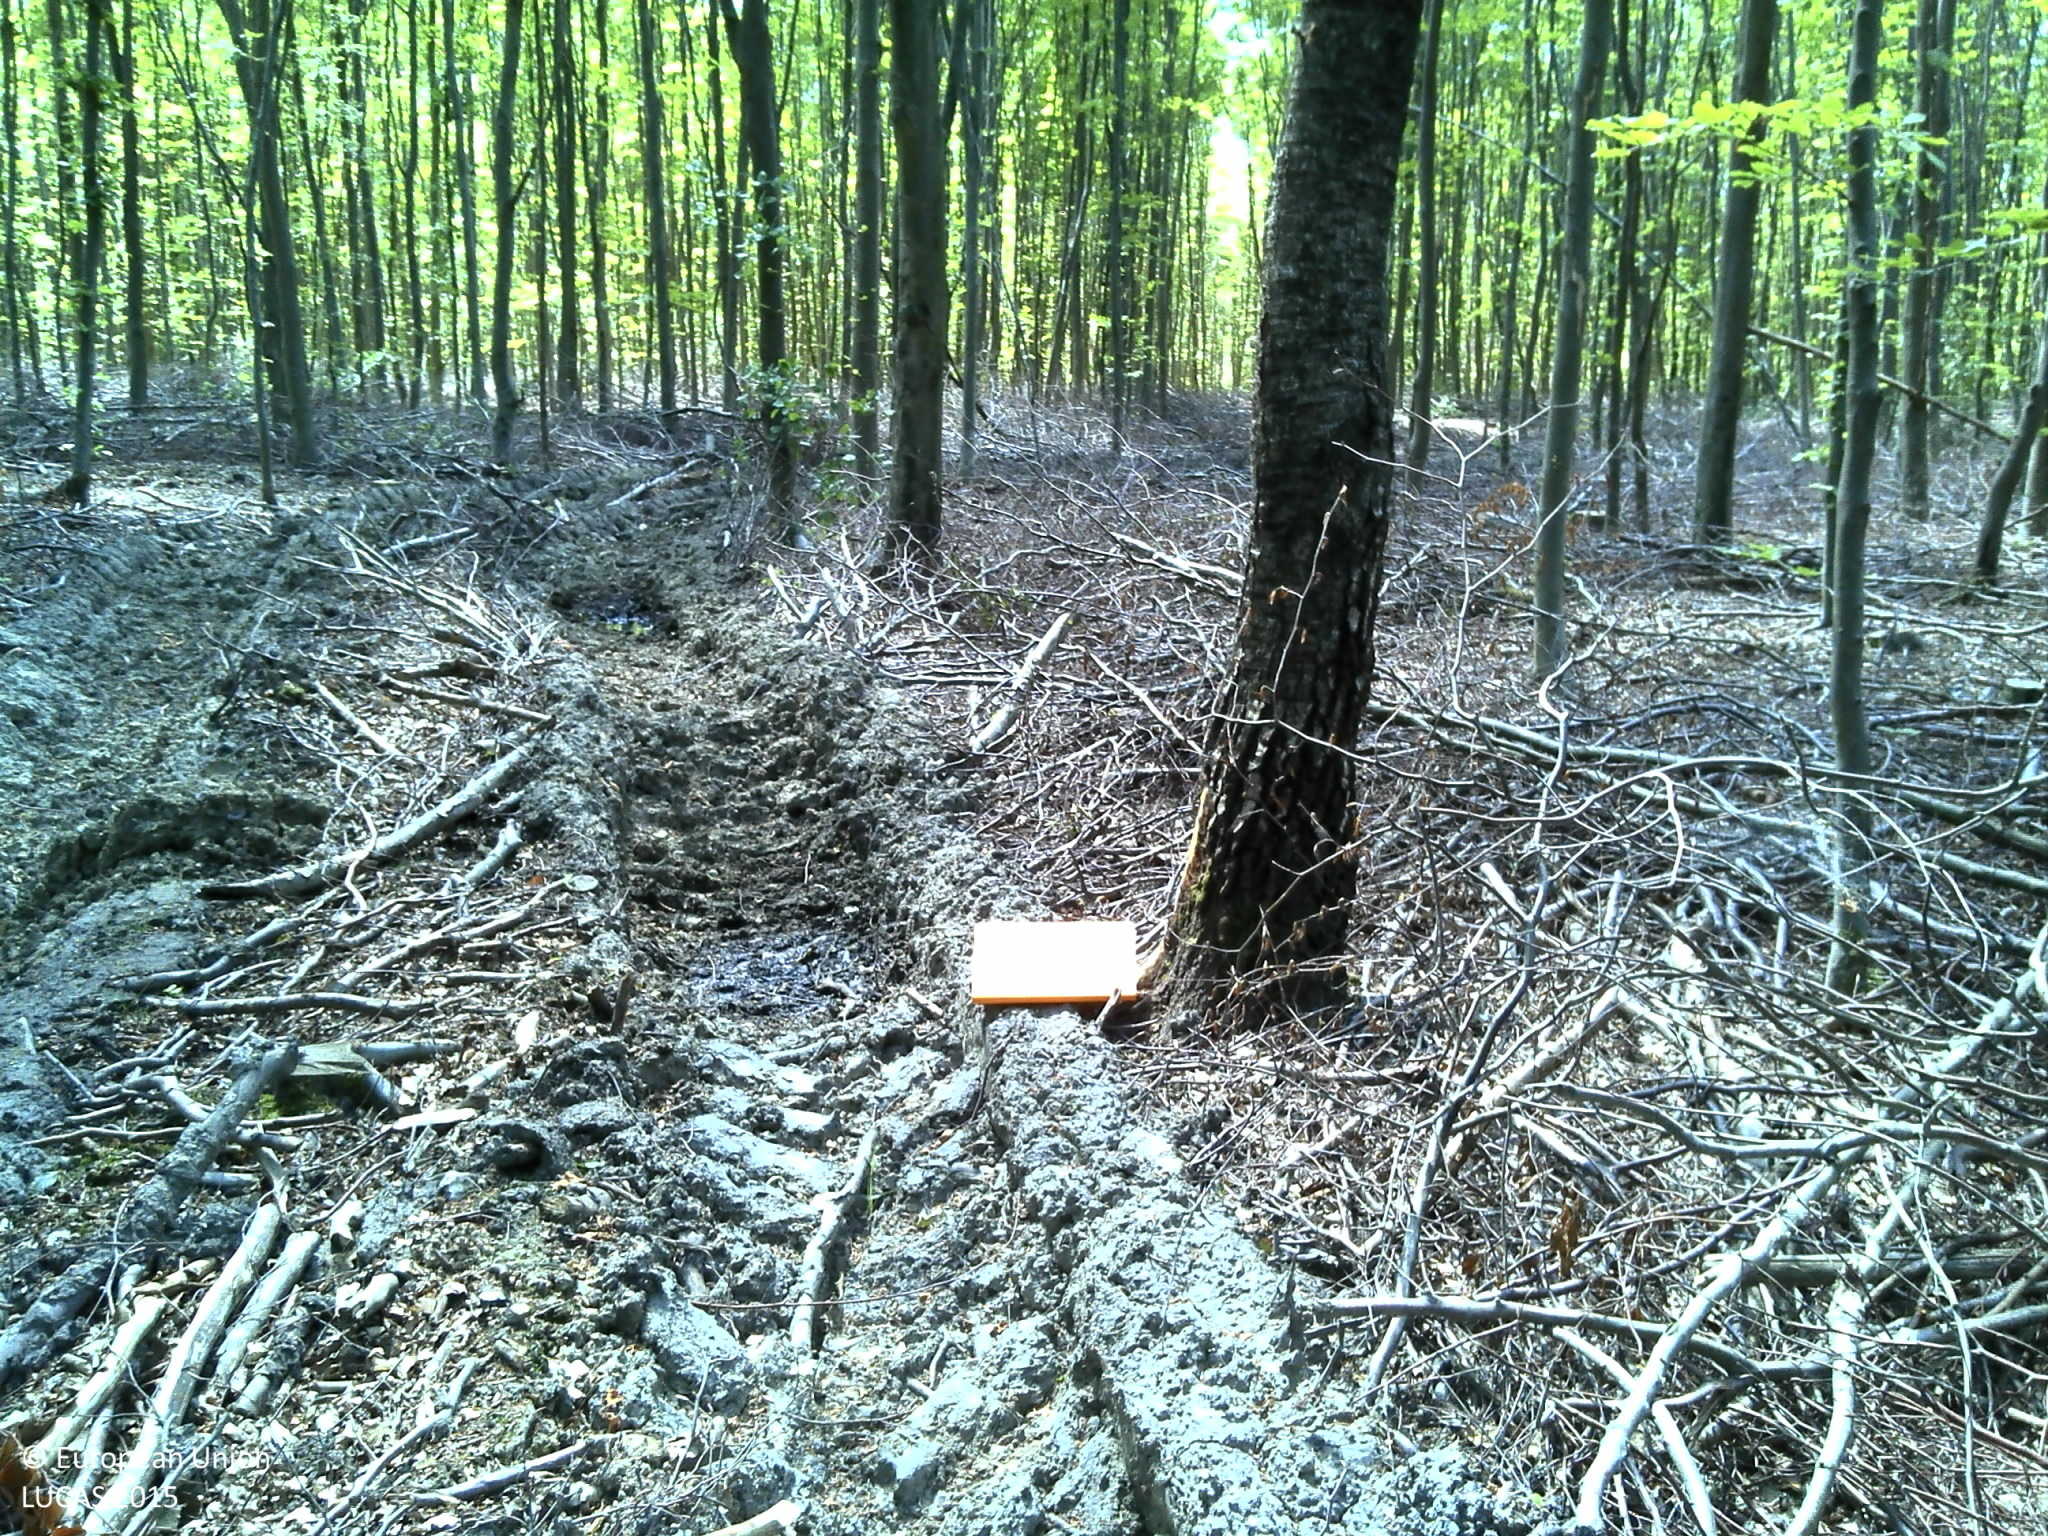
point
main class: Woodland
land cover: Broadleaved woodland
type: beech forest
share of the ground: > 75 %
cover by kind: broadleaved forest trees 90 %, consolidated bare surface 10 %
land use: Forestry
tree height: > 5 m
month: June
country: FR
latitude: 49.5098
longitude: 1.0982
